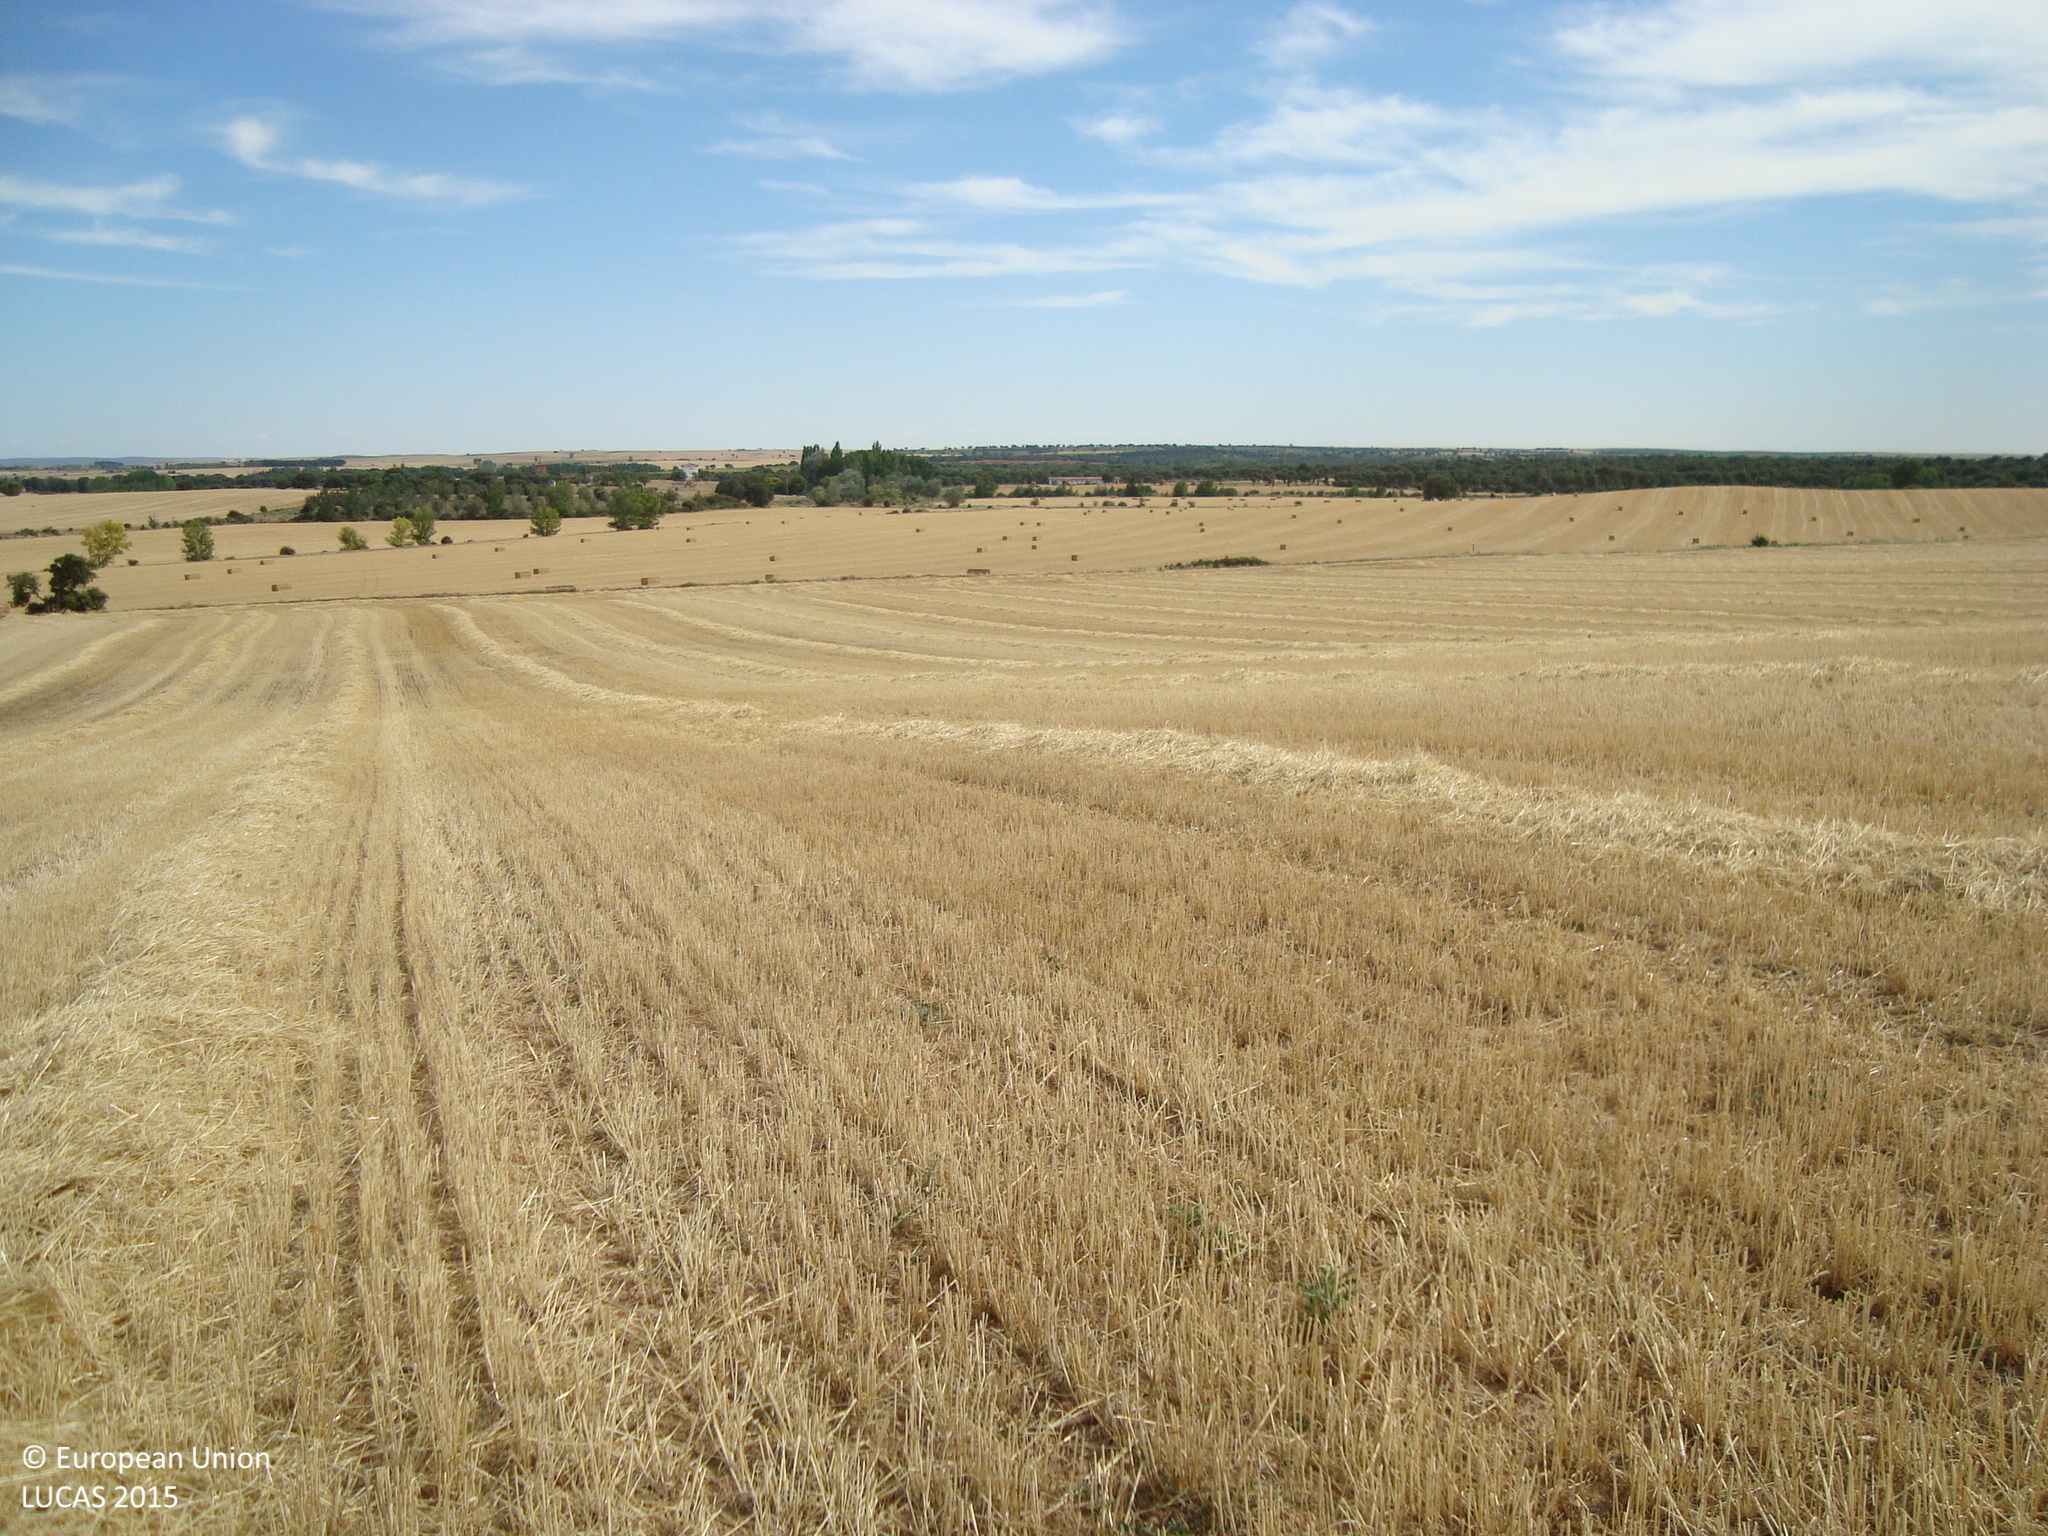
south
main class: Cropland
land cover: Barley
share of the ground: > 75 %
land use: Agriculture (excluding fallow land and kitchen gardens)
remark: Harvested field
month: July
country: ES
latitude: 42.1344
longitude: -3.8649
